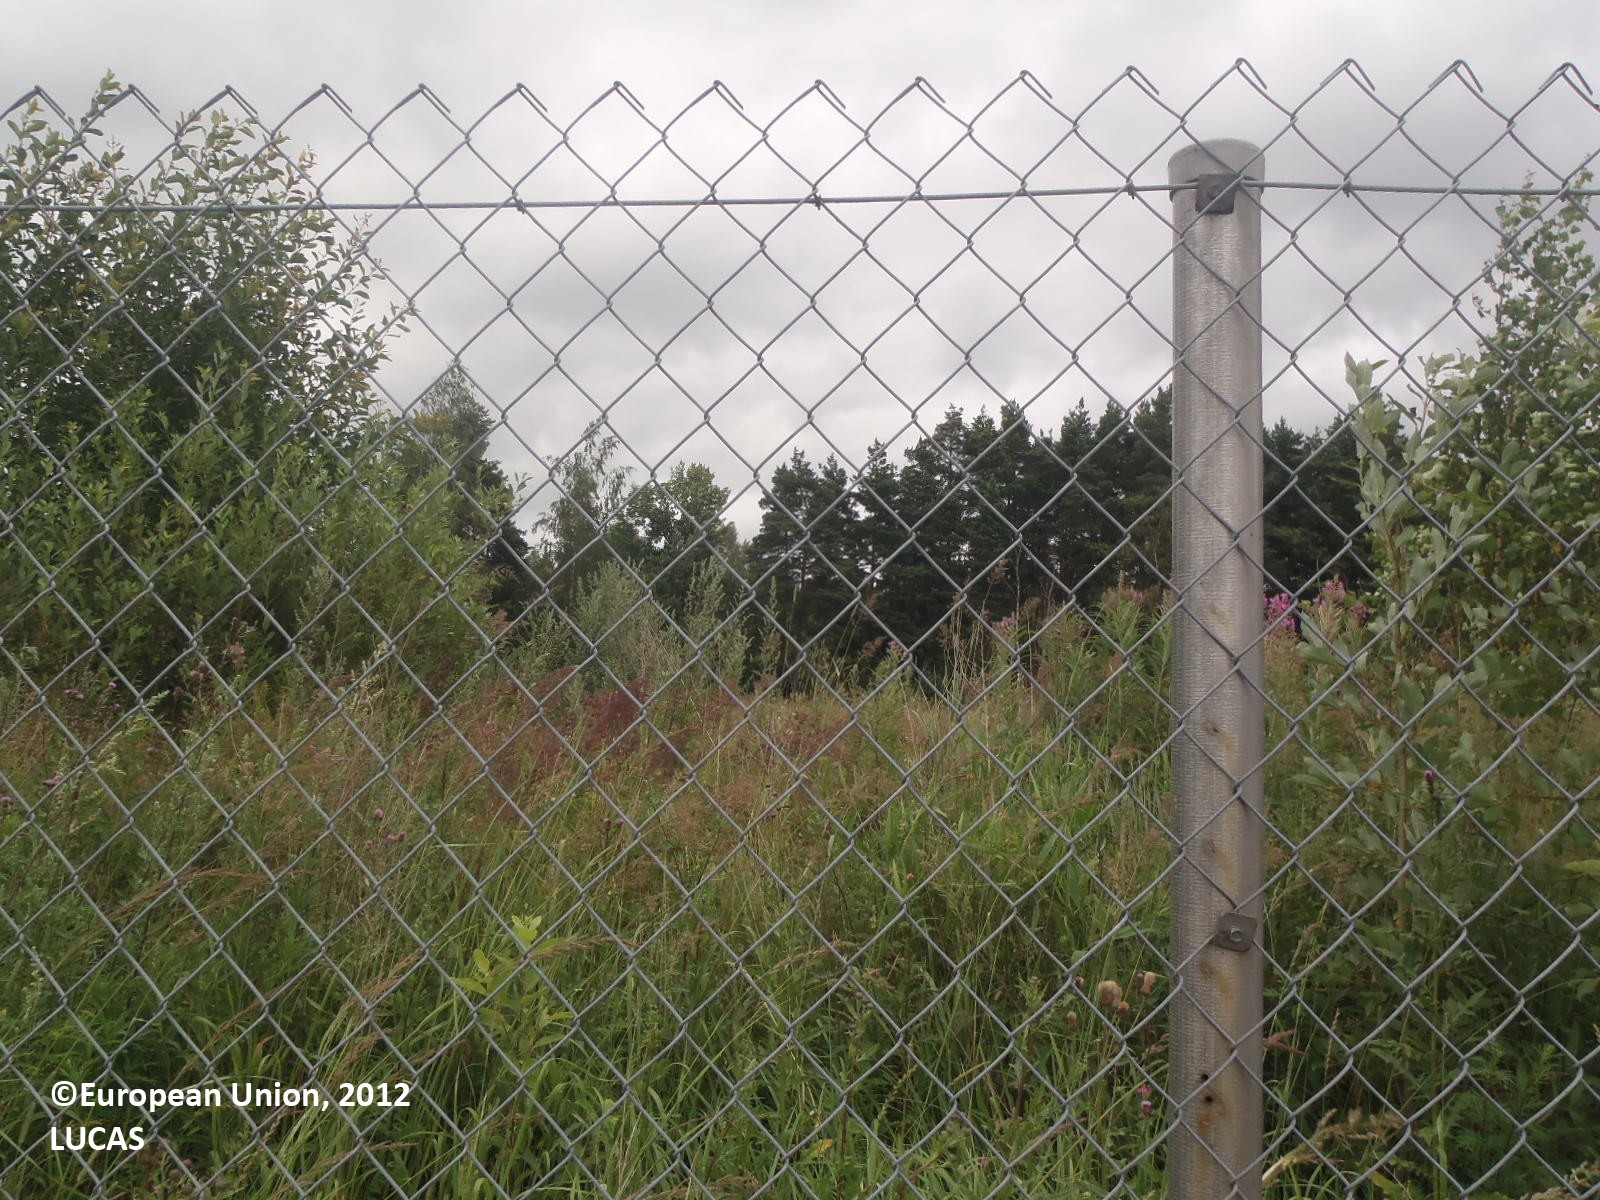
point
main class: Grassland
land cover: Grassland with sparse tree/shrub cover
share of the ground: > 75 %
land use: Abandoned areas
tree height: < 5 m
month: July
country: FI
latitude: 60.5024
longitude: 22.2469
